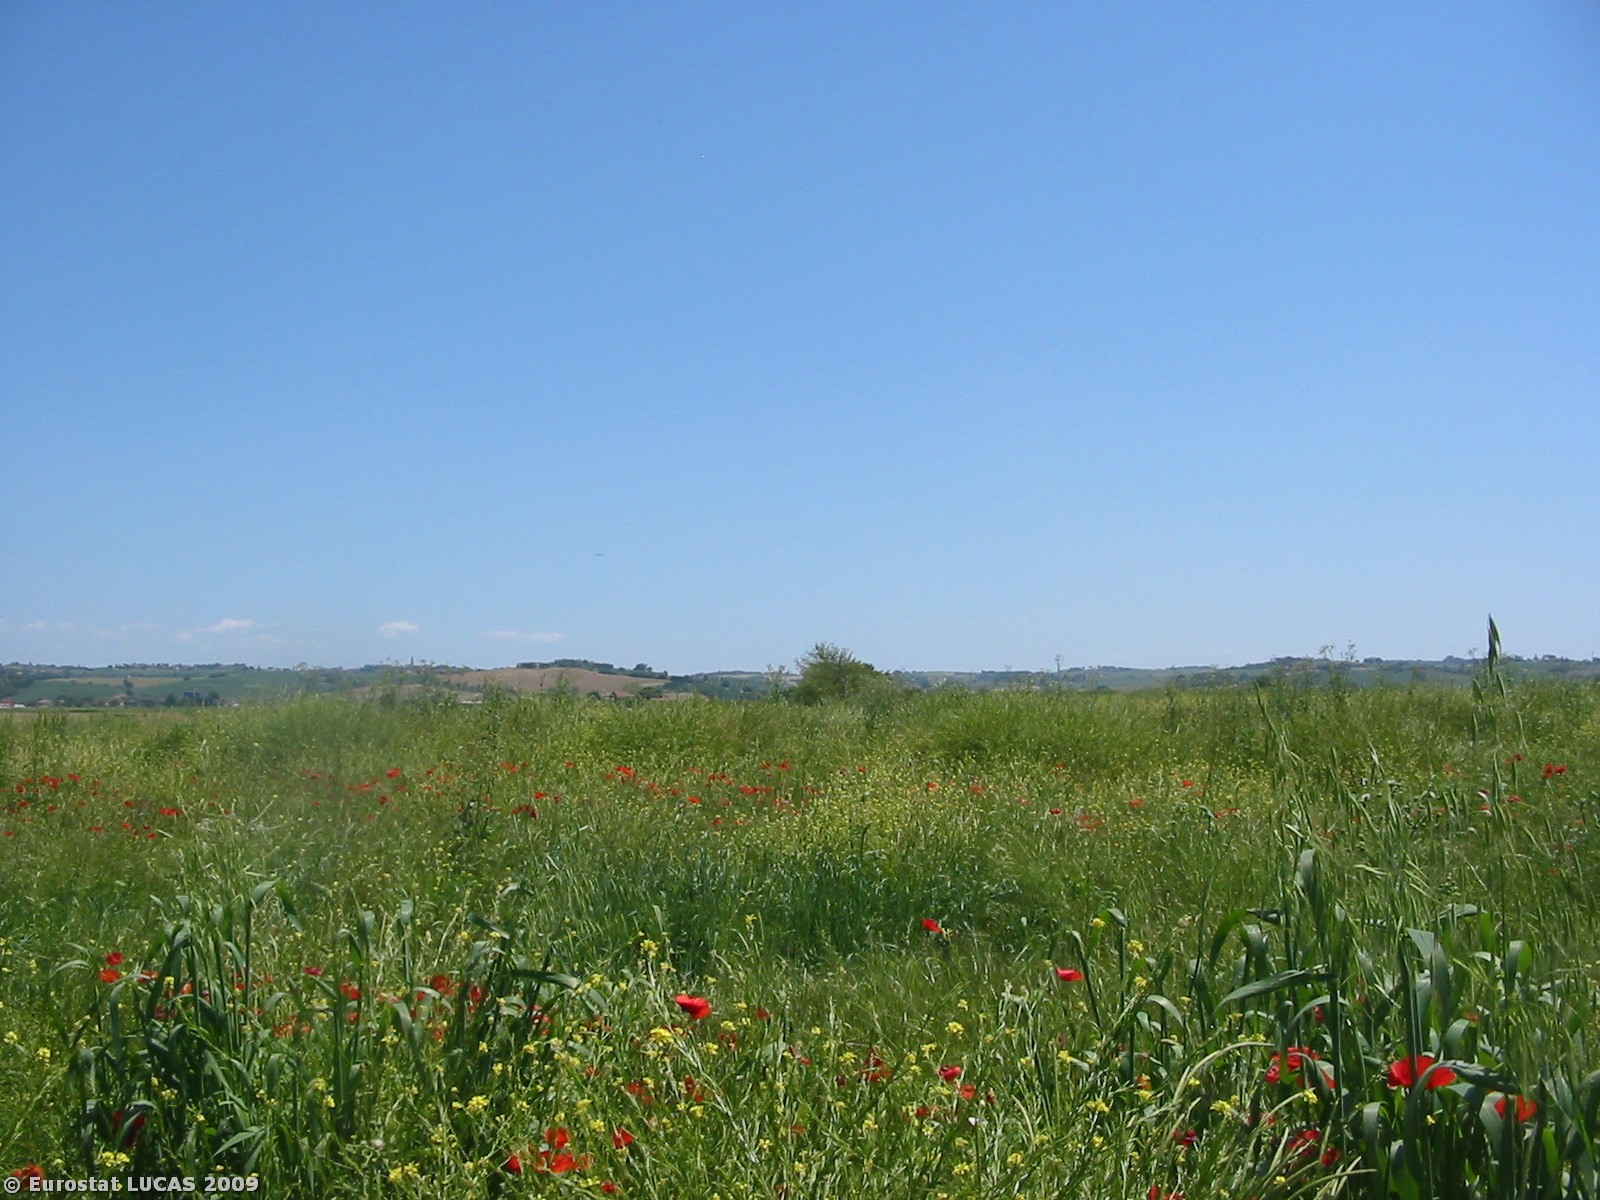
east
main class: Grassland
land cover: Spontaneously vegetated surfaces
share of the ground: > 75 %
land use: Fallow land
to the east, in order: Spontaneously vegetated surfaces; Ditches and canals; Spontaneously vegetated surfaces
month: May
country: IT
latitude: 43.1058
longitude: 11.8990
